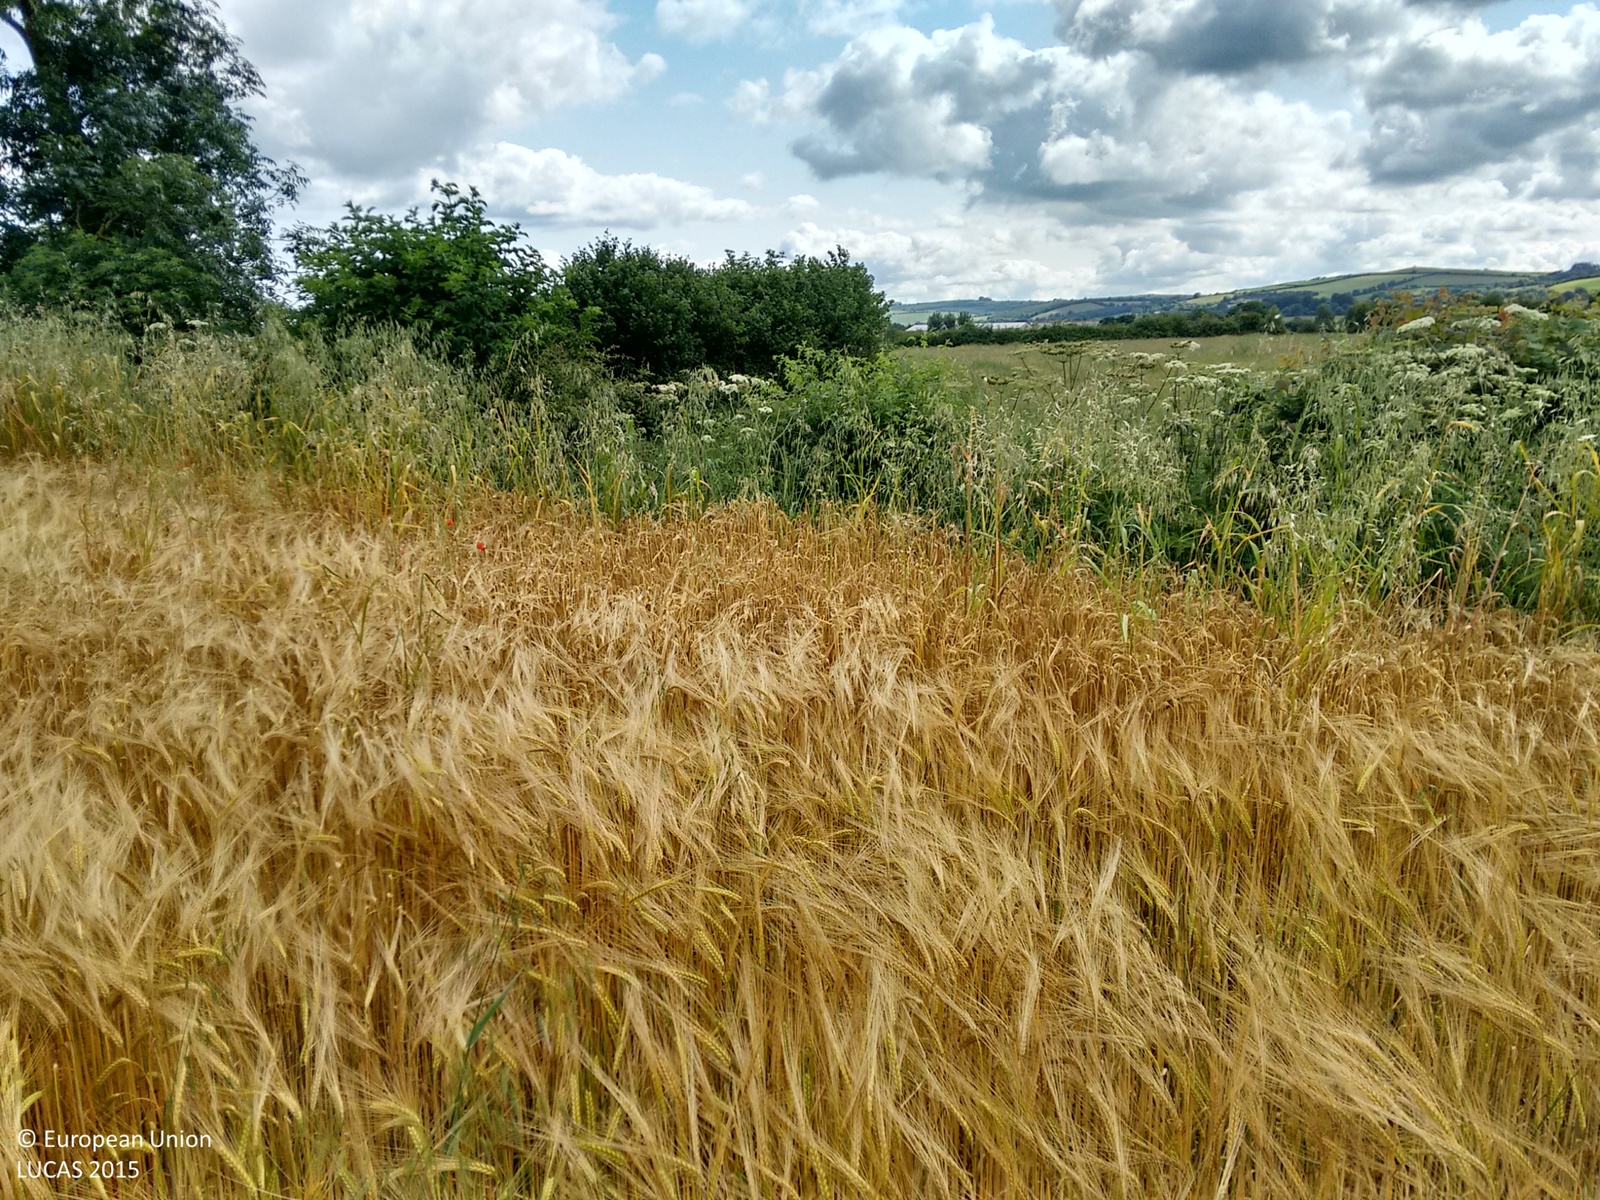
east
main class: Cropland
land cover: Triticale
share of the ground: > 75 %
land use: Agriculture (excluding fallow land and kitchen gardens)
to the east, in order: Triticale; Abandoned hedges; Fences; Grassland without tree/shrub cover; Fences; Abandoned hedges; Ditches and canals; Fences; Grassland without tree/shrub cover
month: July
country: IE
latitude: 52.6477
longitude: -7.6185
